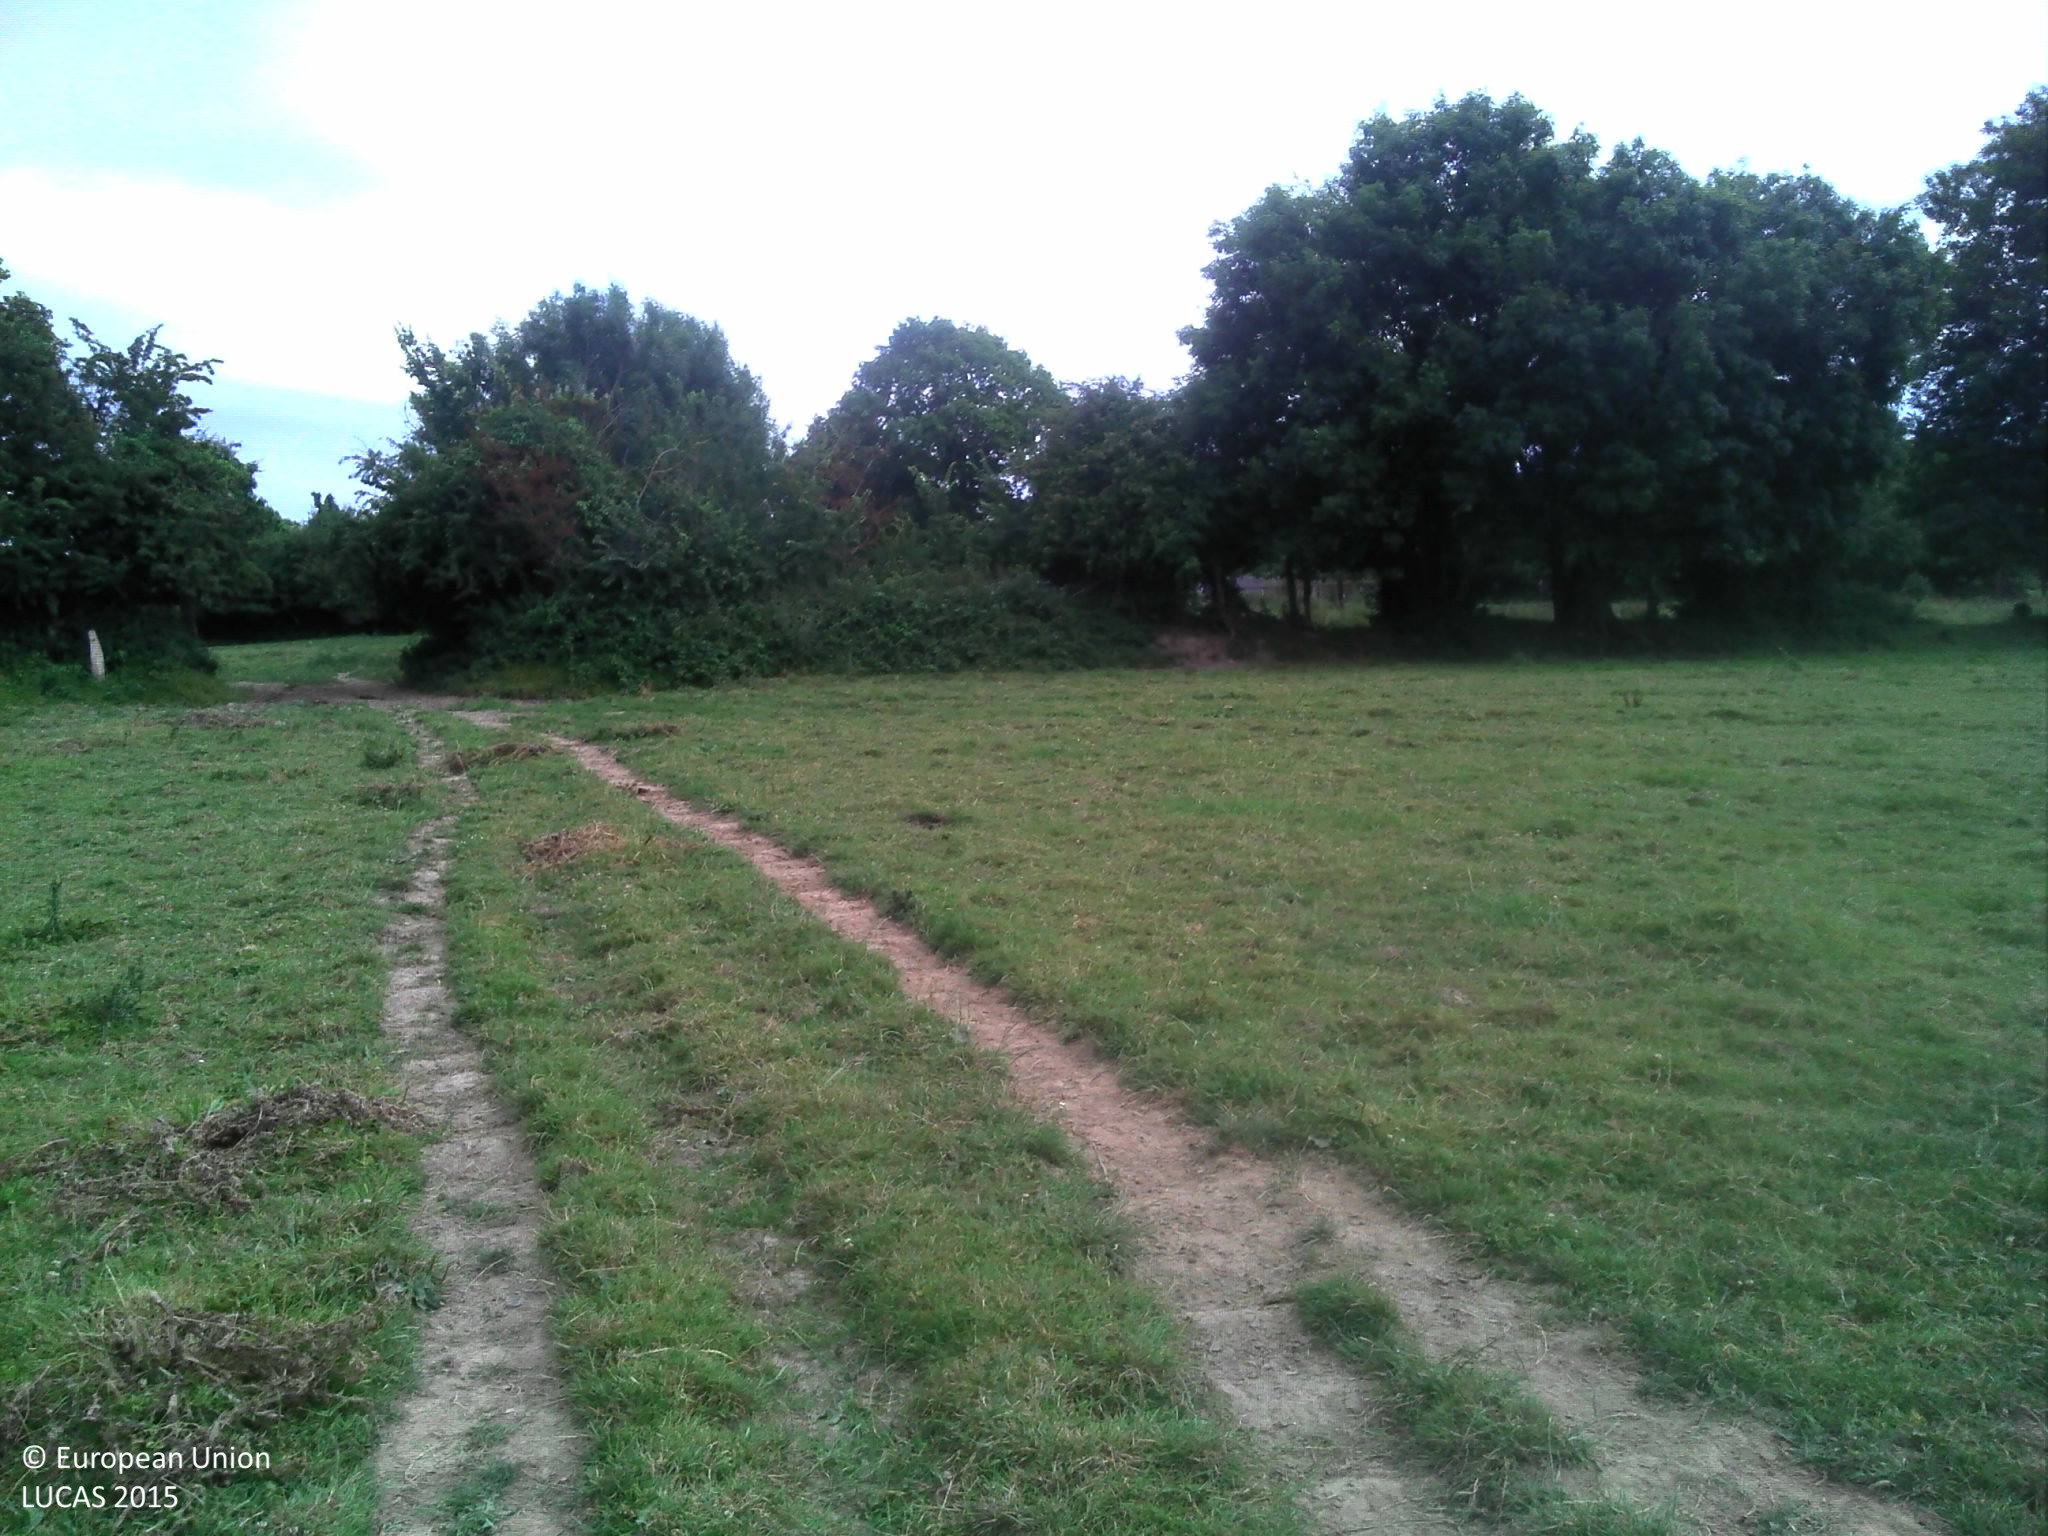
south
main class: Grassland
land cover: Grassland without tree/shrub cover
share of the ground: > 75 %
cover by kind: herbaceous plants 100 %
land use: Agriculture (excluding fallow land and kitchen gardens)
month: July
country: FR
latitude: 48.8308
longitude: -1.5600
